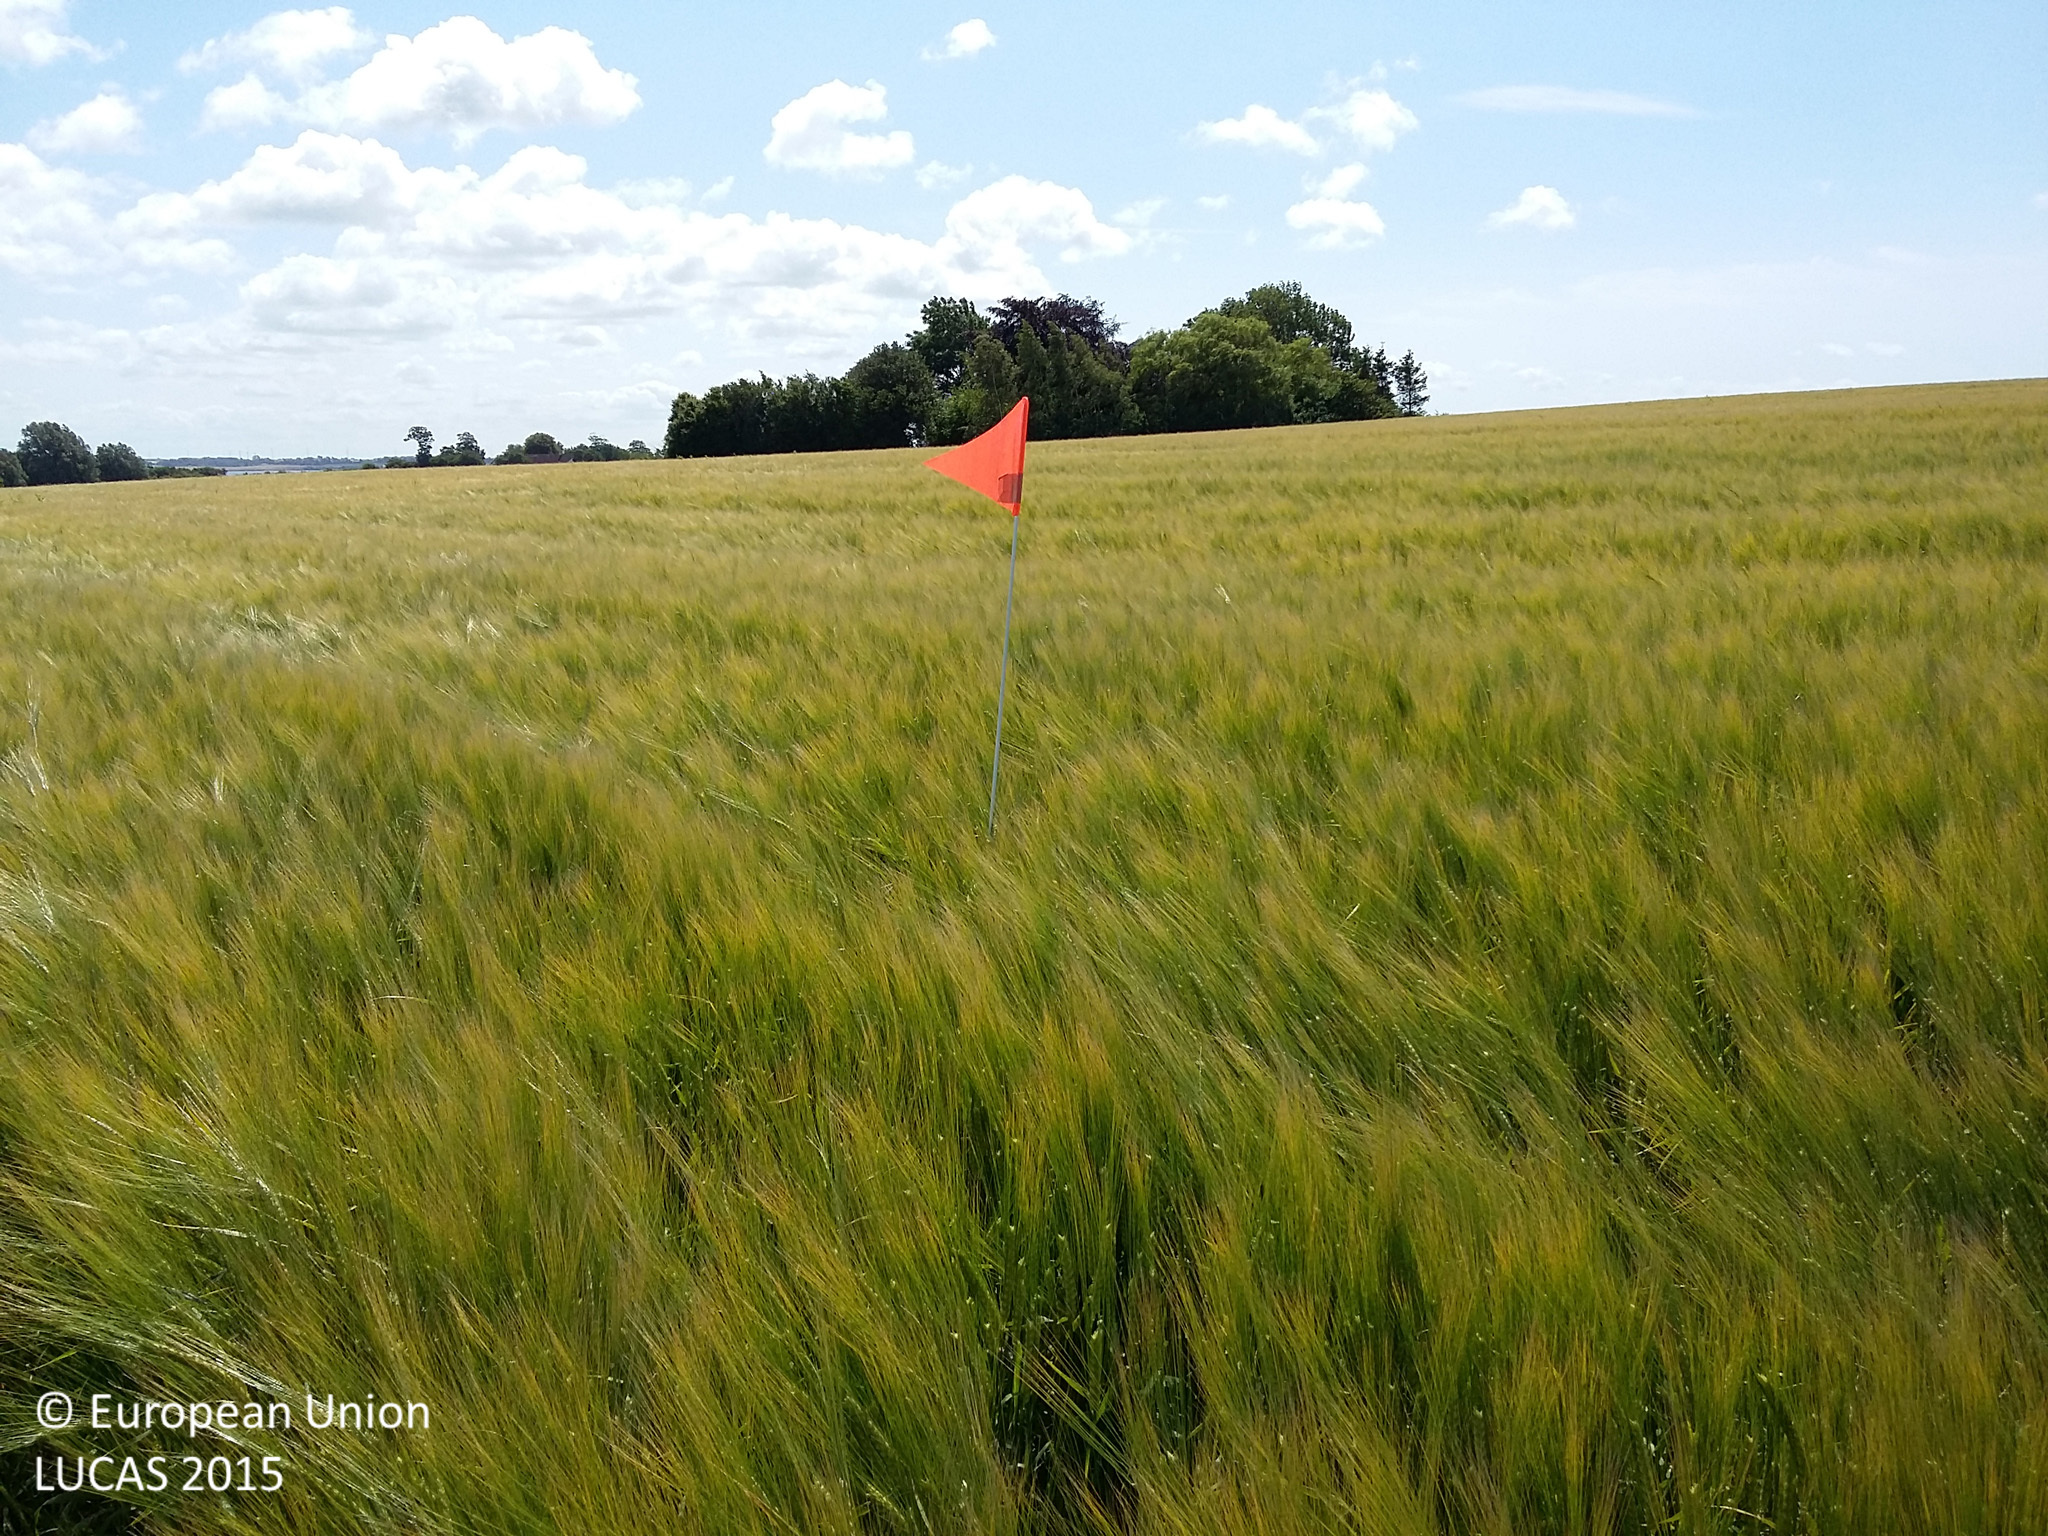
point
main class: Cropland
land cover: Barley
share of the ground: > 75 %
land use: Agriculture (excluding fallow land and kitchen gardens)
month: July
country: DK
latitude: 55.5884
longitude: 11.2523
